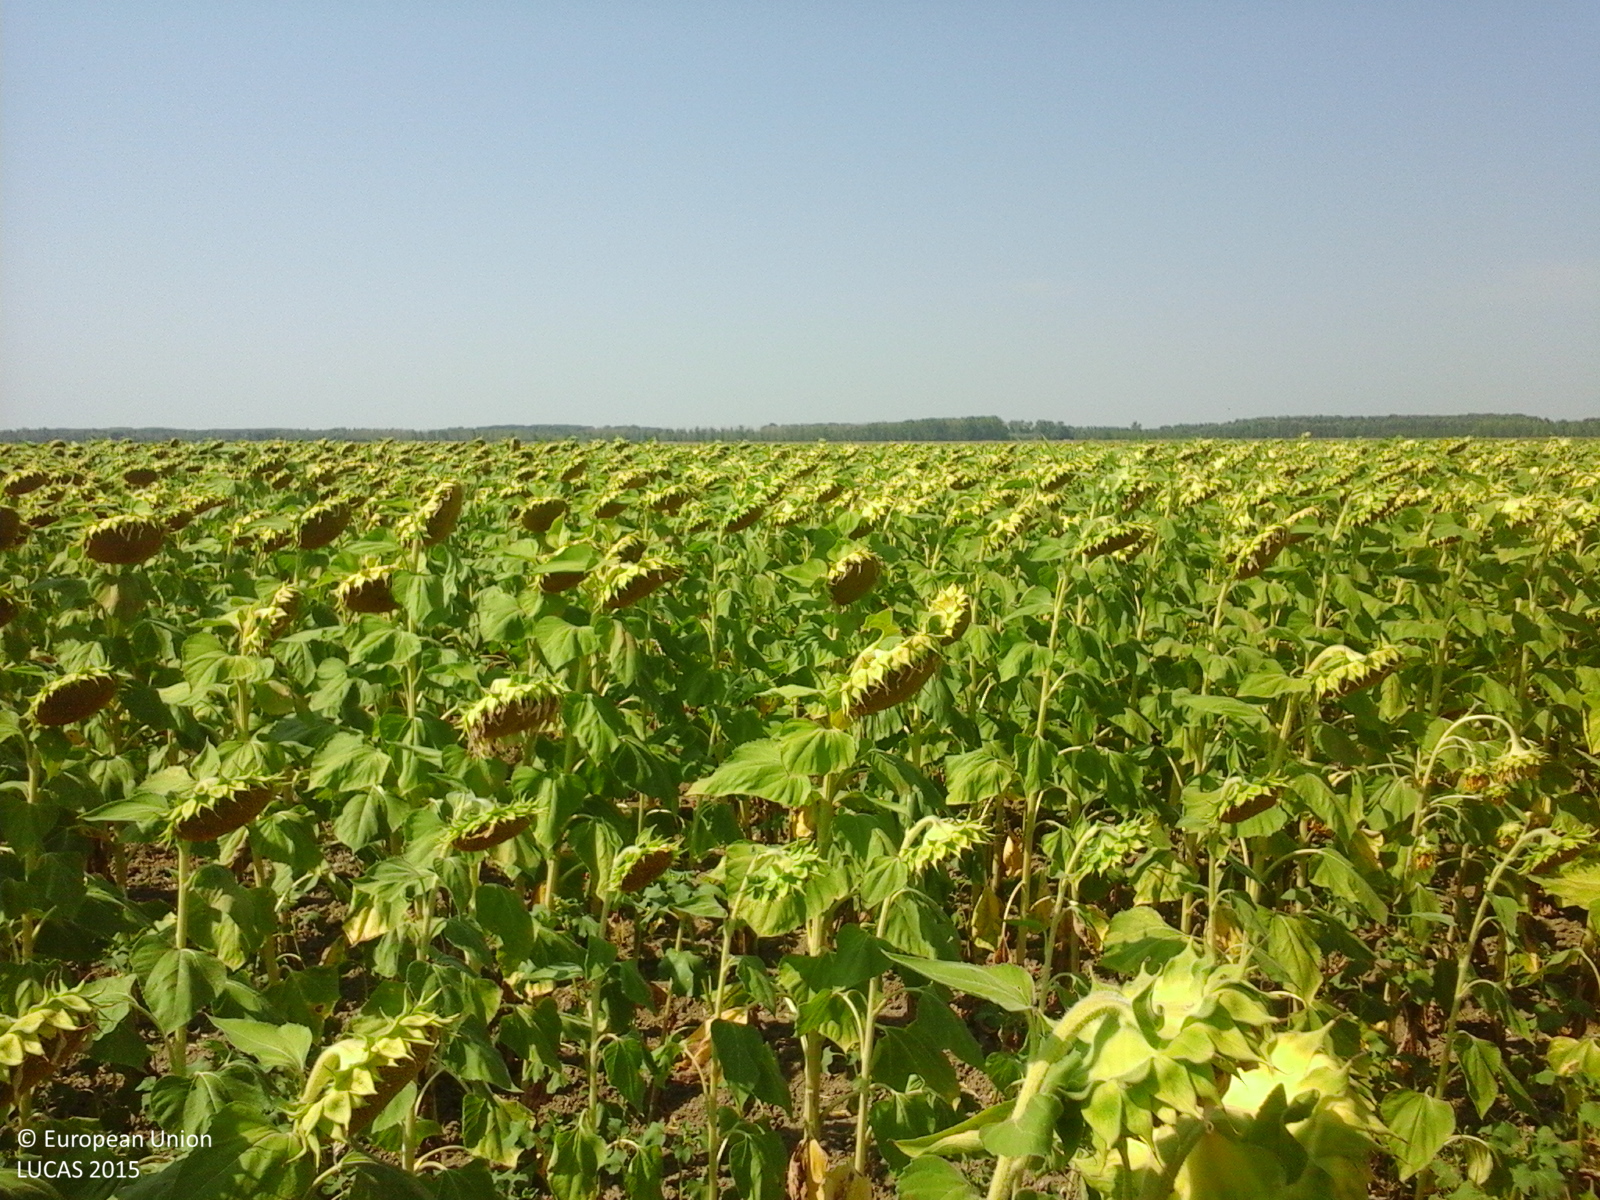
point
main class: Cropland
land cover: Sunflower
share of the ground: > 75 %
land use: Agriculture (excluding fallow land and kitchen gardens)
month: August
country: RO
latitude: 45.3864
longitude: 27.8523
